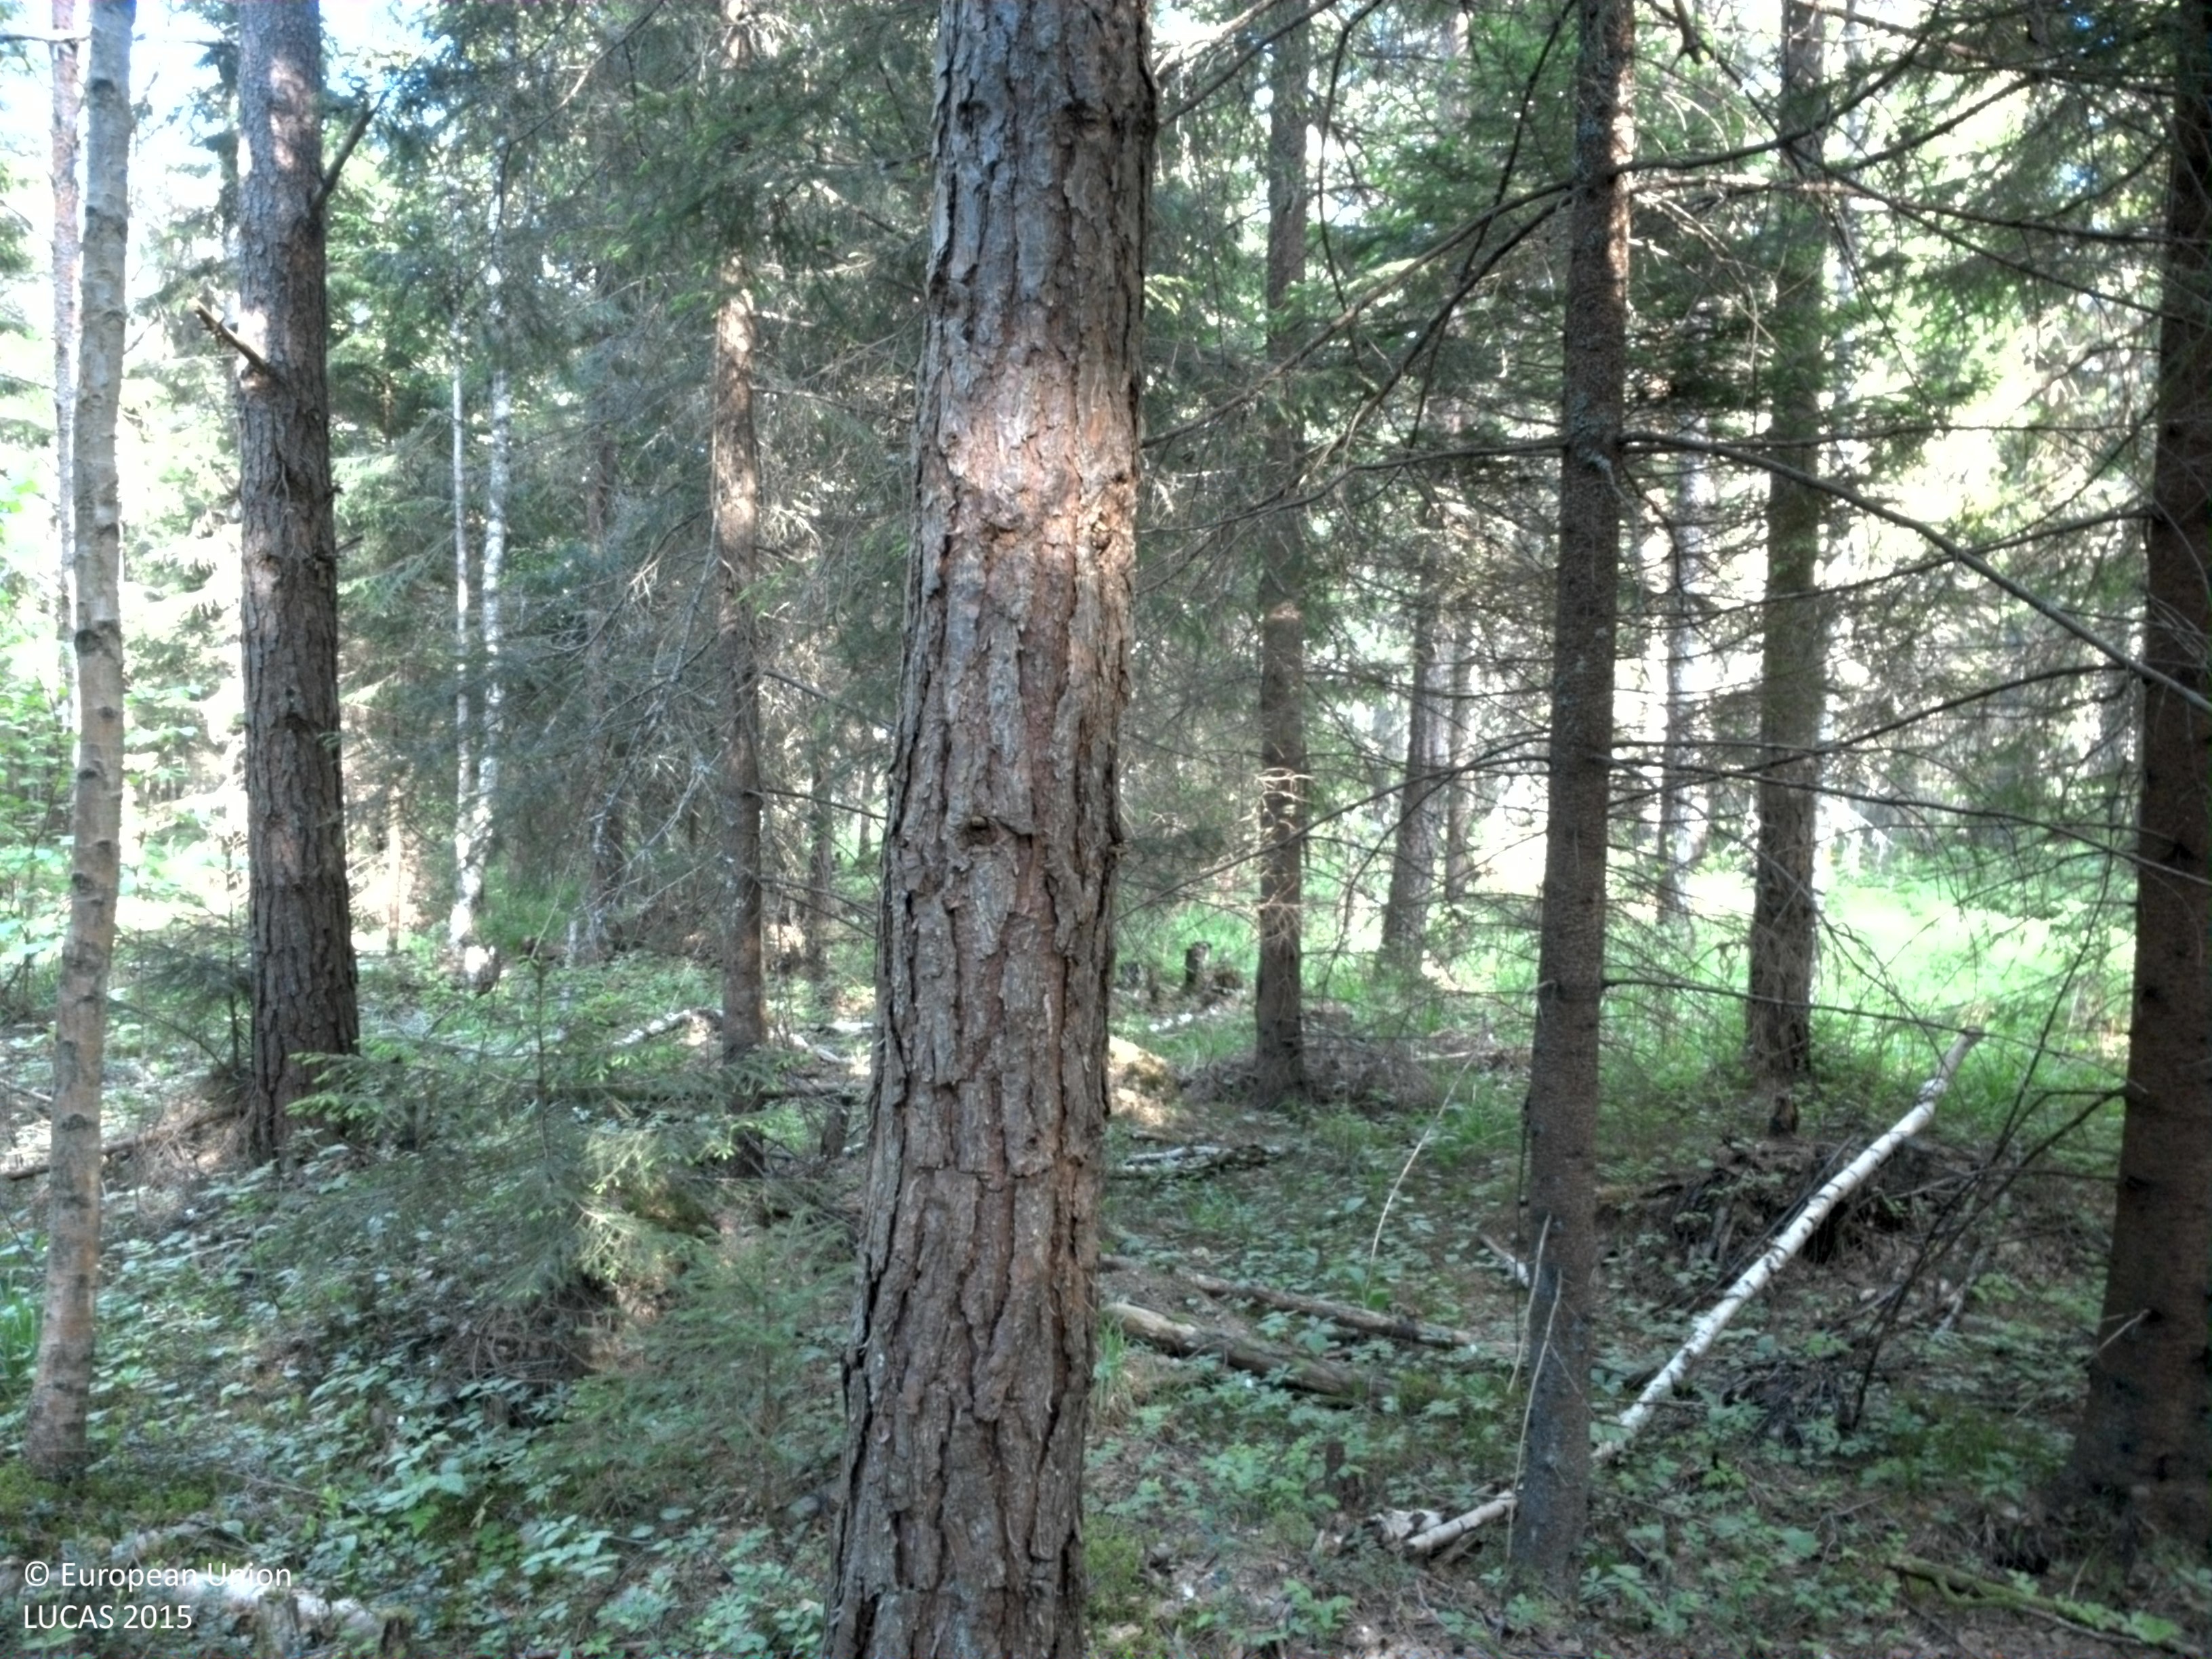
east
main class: Woodland
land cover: Pine dominated coniferous woodland
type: boreal forest
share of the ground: > 75 %
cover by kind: coniferous forest trees 85 %, broadleaved forest trees 5 %, herbaceous plants 5 %, lichens and mosses 5 %
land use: Forestry
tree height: > 5 m
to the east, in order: Pine dominated coniferous woodland; Spruce dominated coniferous woodland; Ditches and canals; Spruce dominated coniferous woodland; Pine dominated coniferous woodland
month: June
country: SE
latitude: 60.0115
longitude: 18.8422
